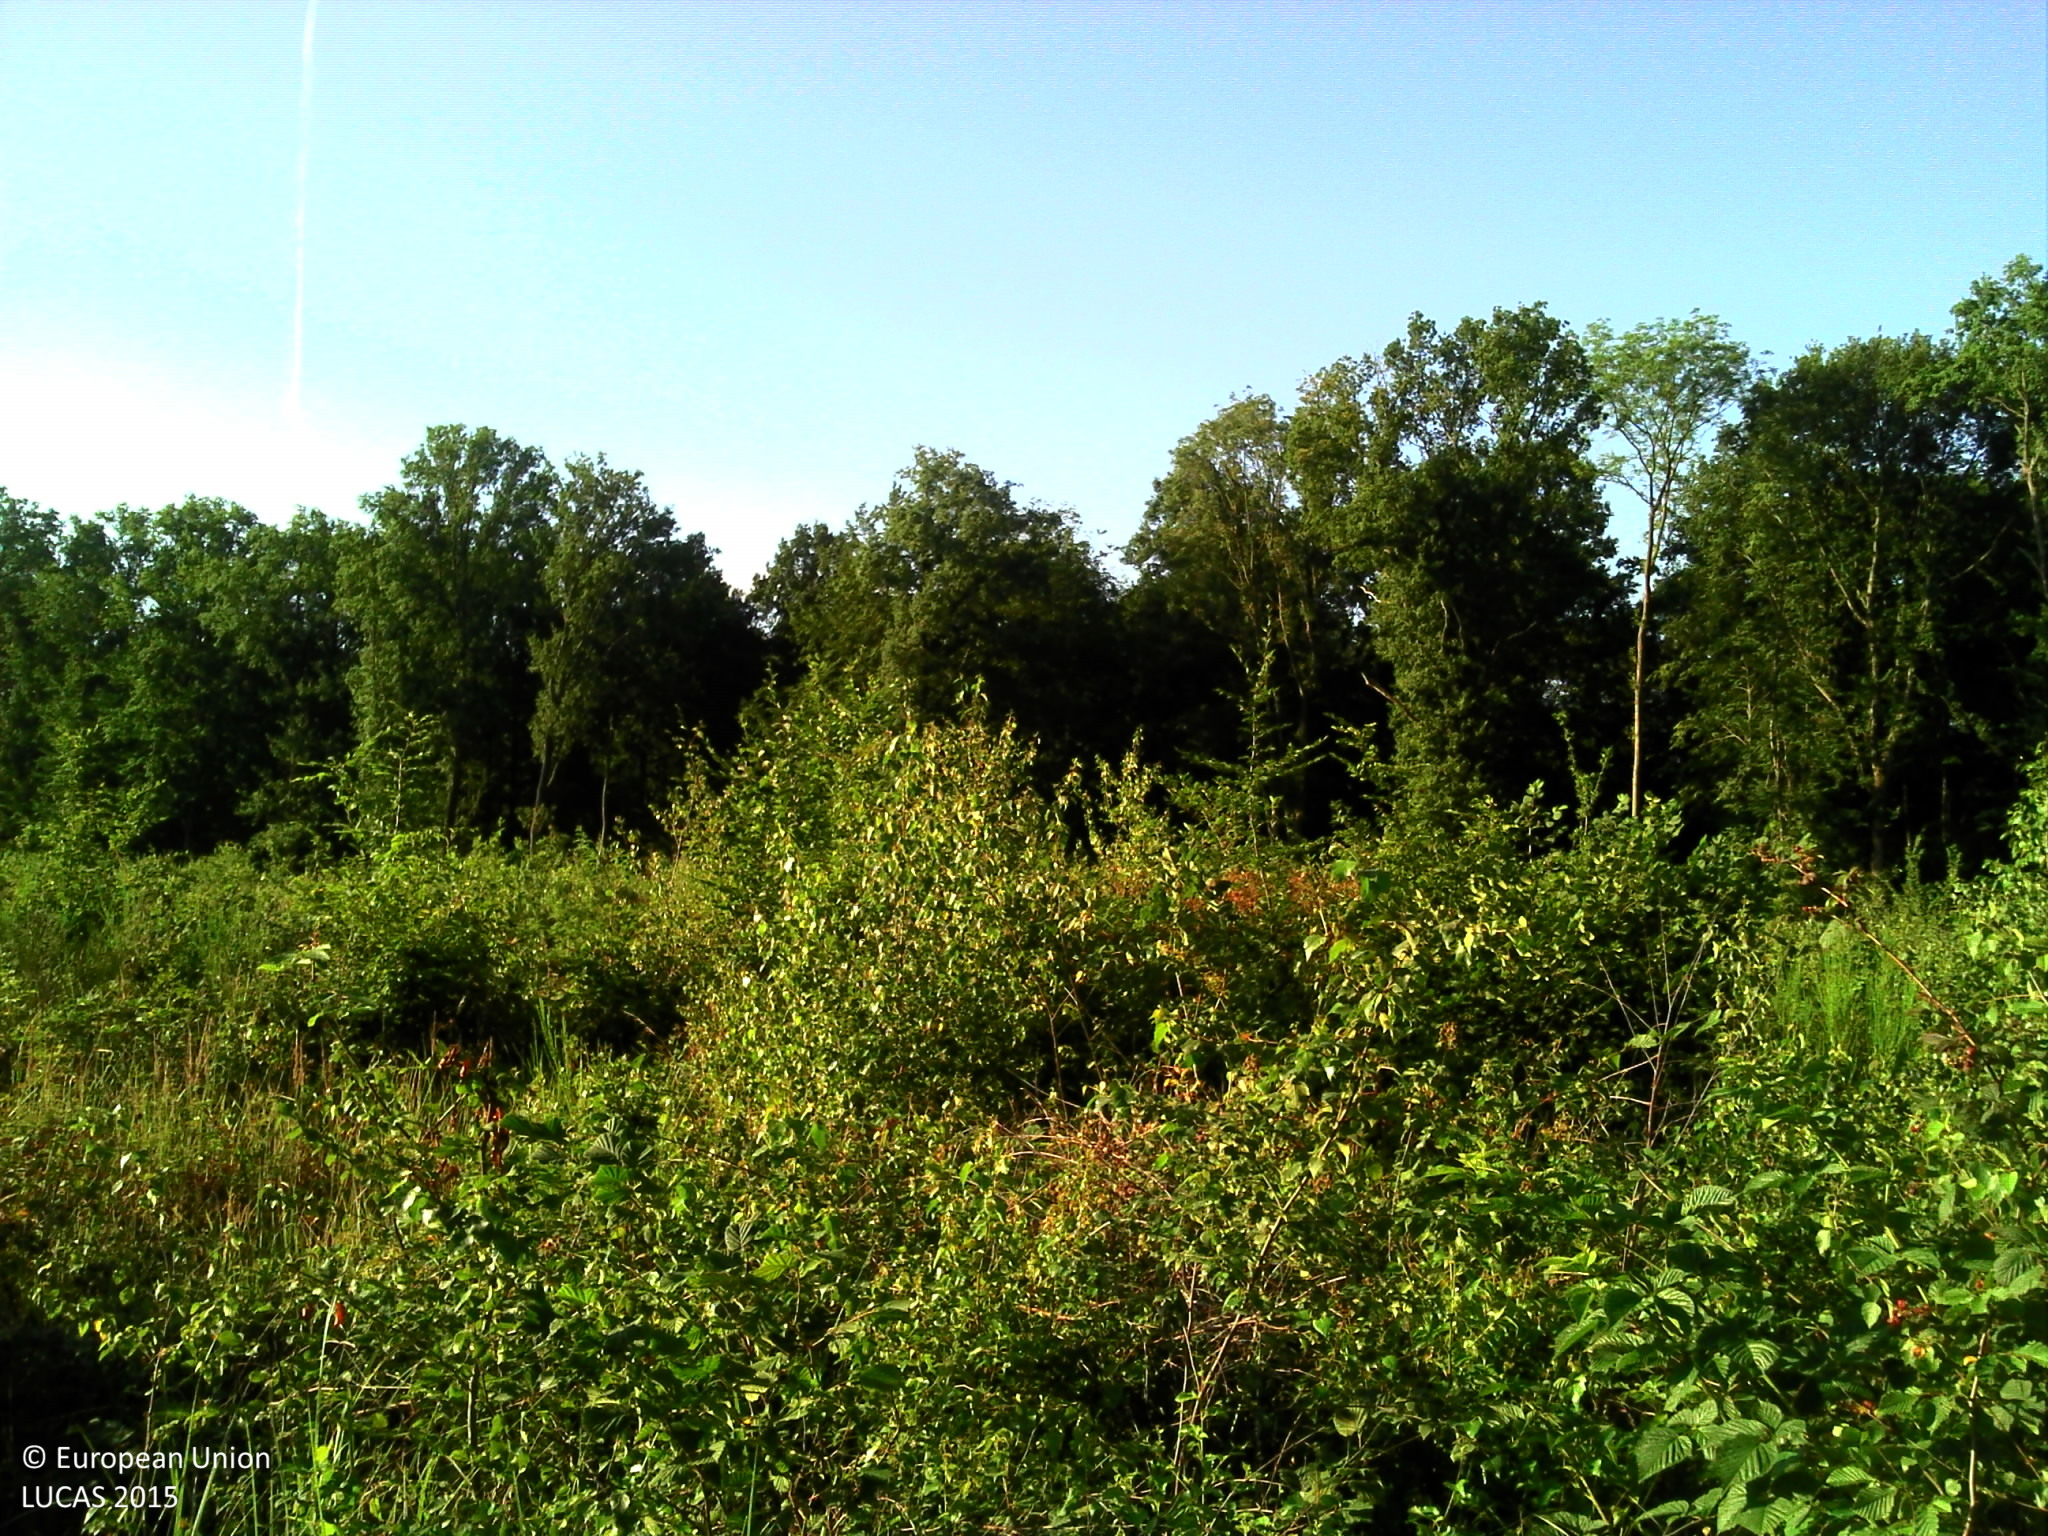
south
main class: Shrubland
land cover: Shrubland without tree cover
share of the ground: > 75 %
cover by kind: shrubs 65 %, herbaceous plants 35 %
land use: Semi-natural and natural areas not in use
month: July
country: FR
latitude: 49.2741
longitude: 2.5803
